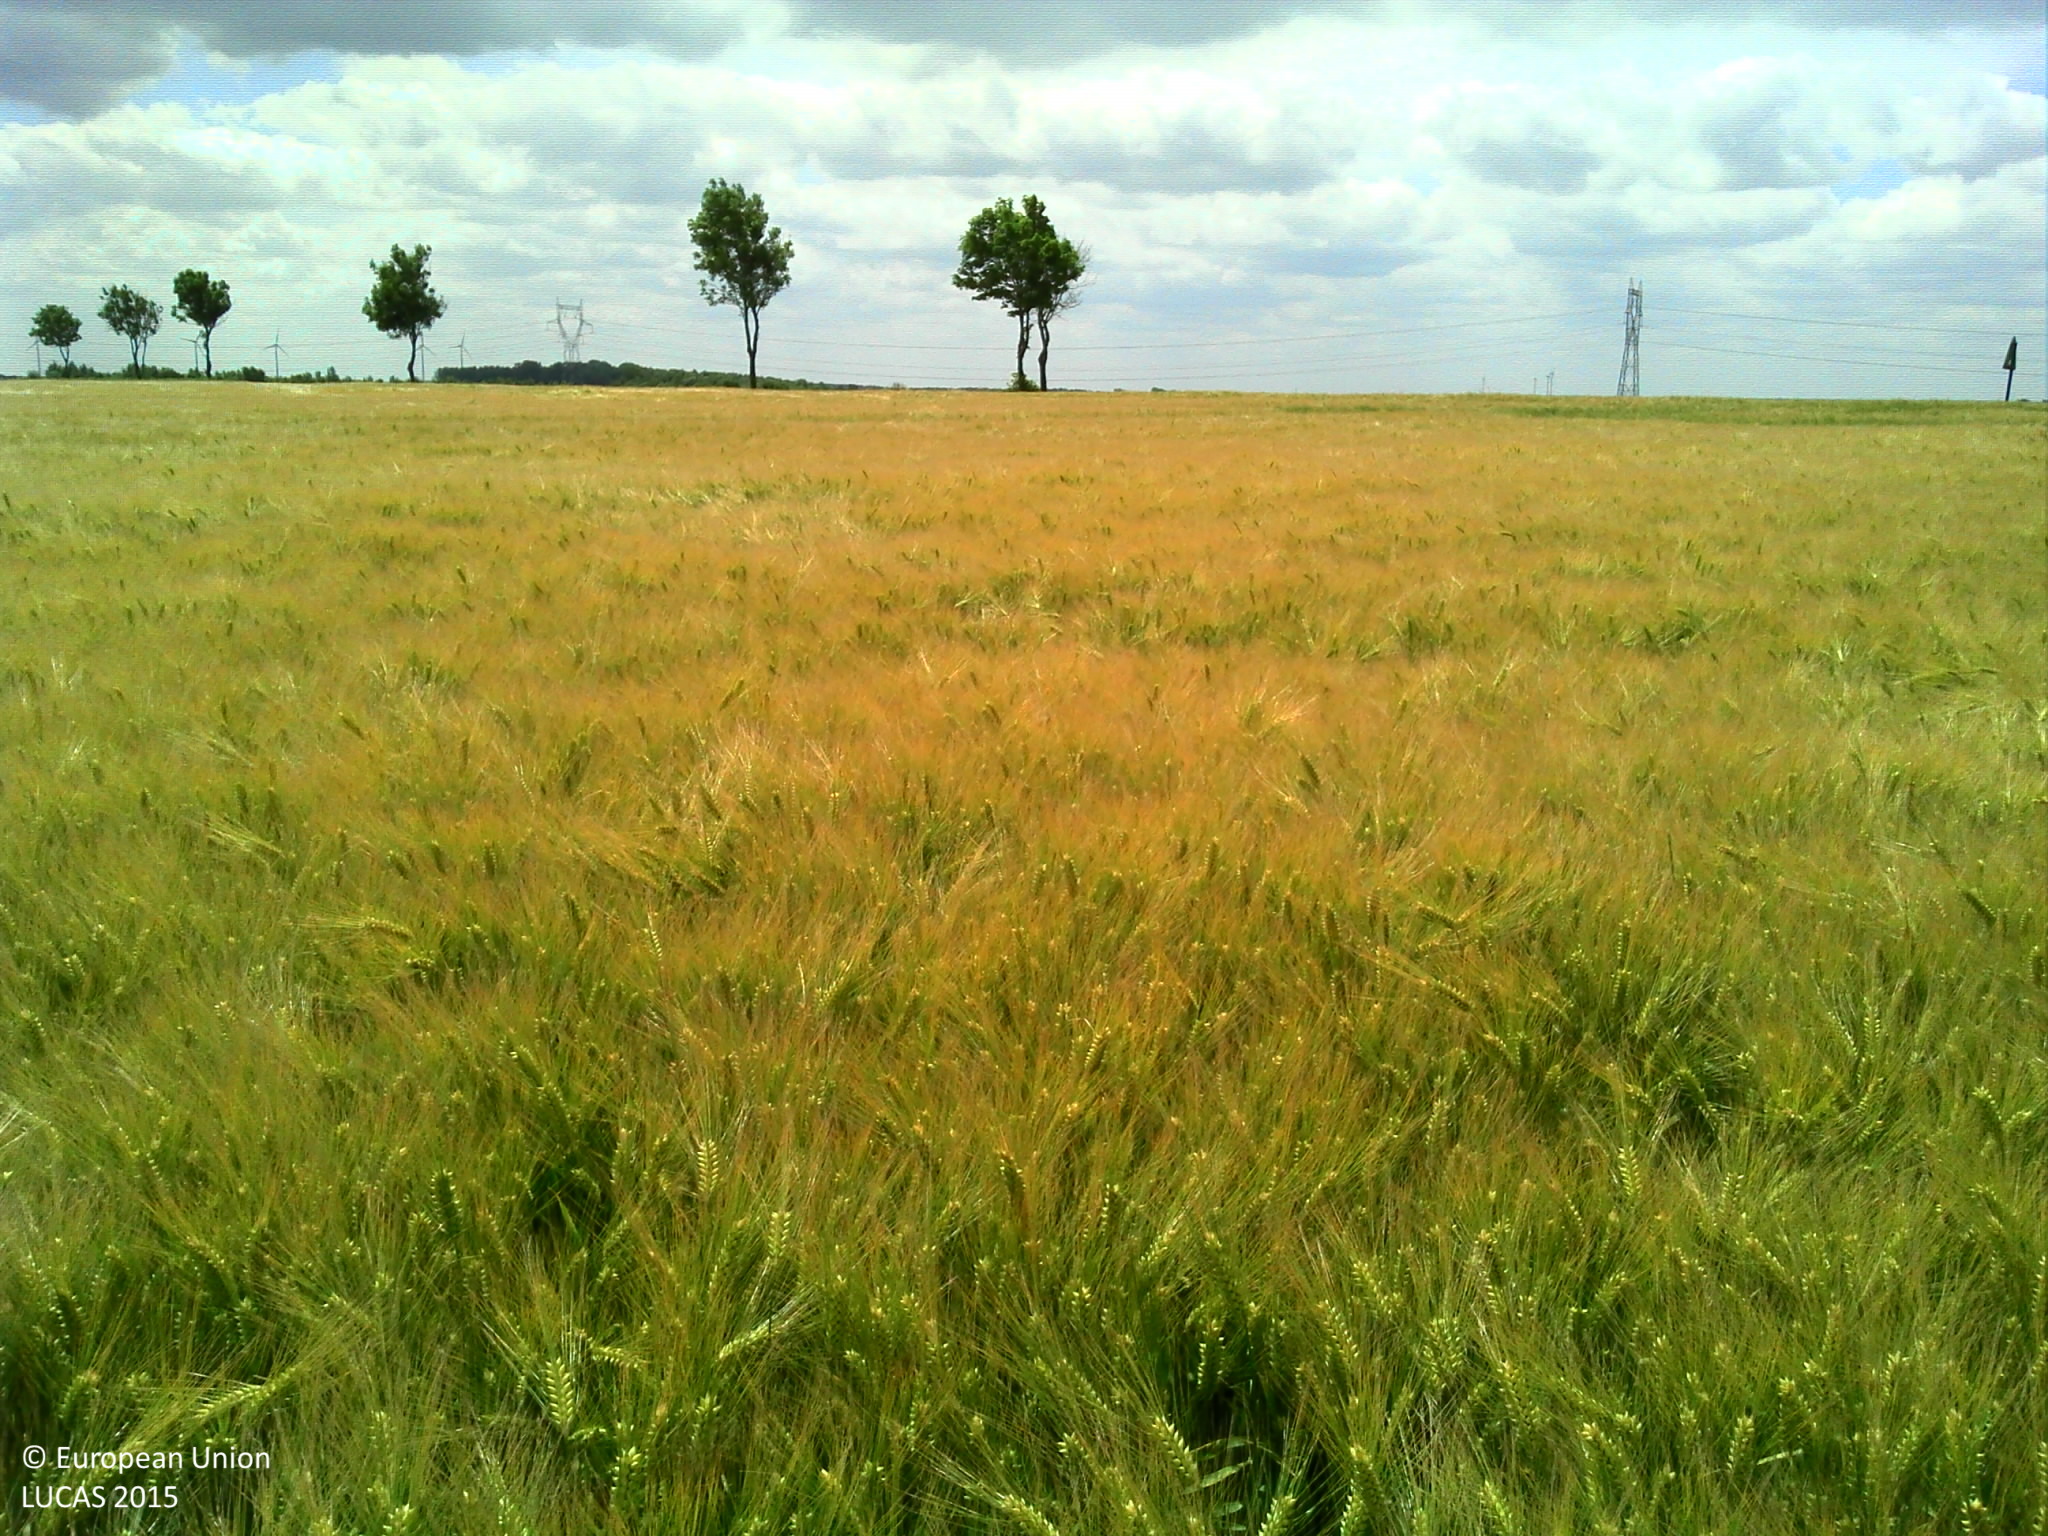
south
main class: Cropland
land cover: Barley
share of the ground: > 75 %
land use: Agriculture (excluding fallow land and kitchen gardens)
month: June
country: FR
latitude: 50.3861
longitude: 2.4627
